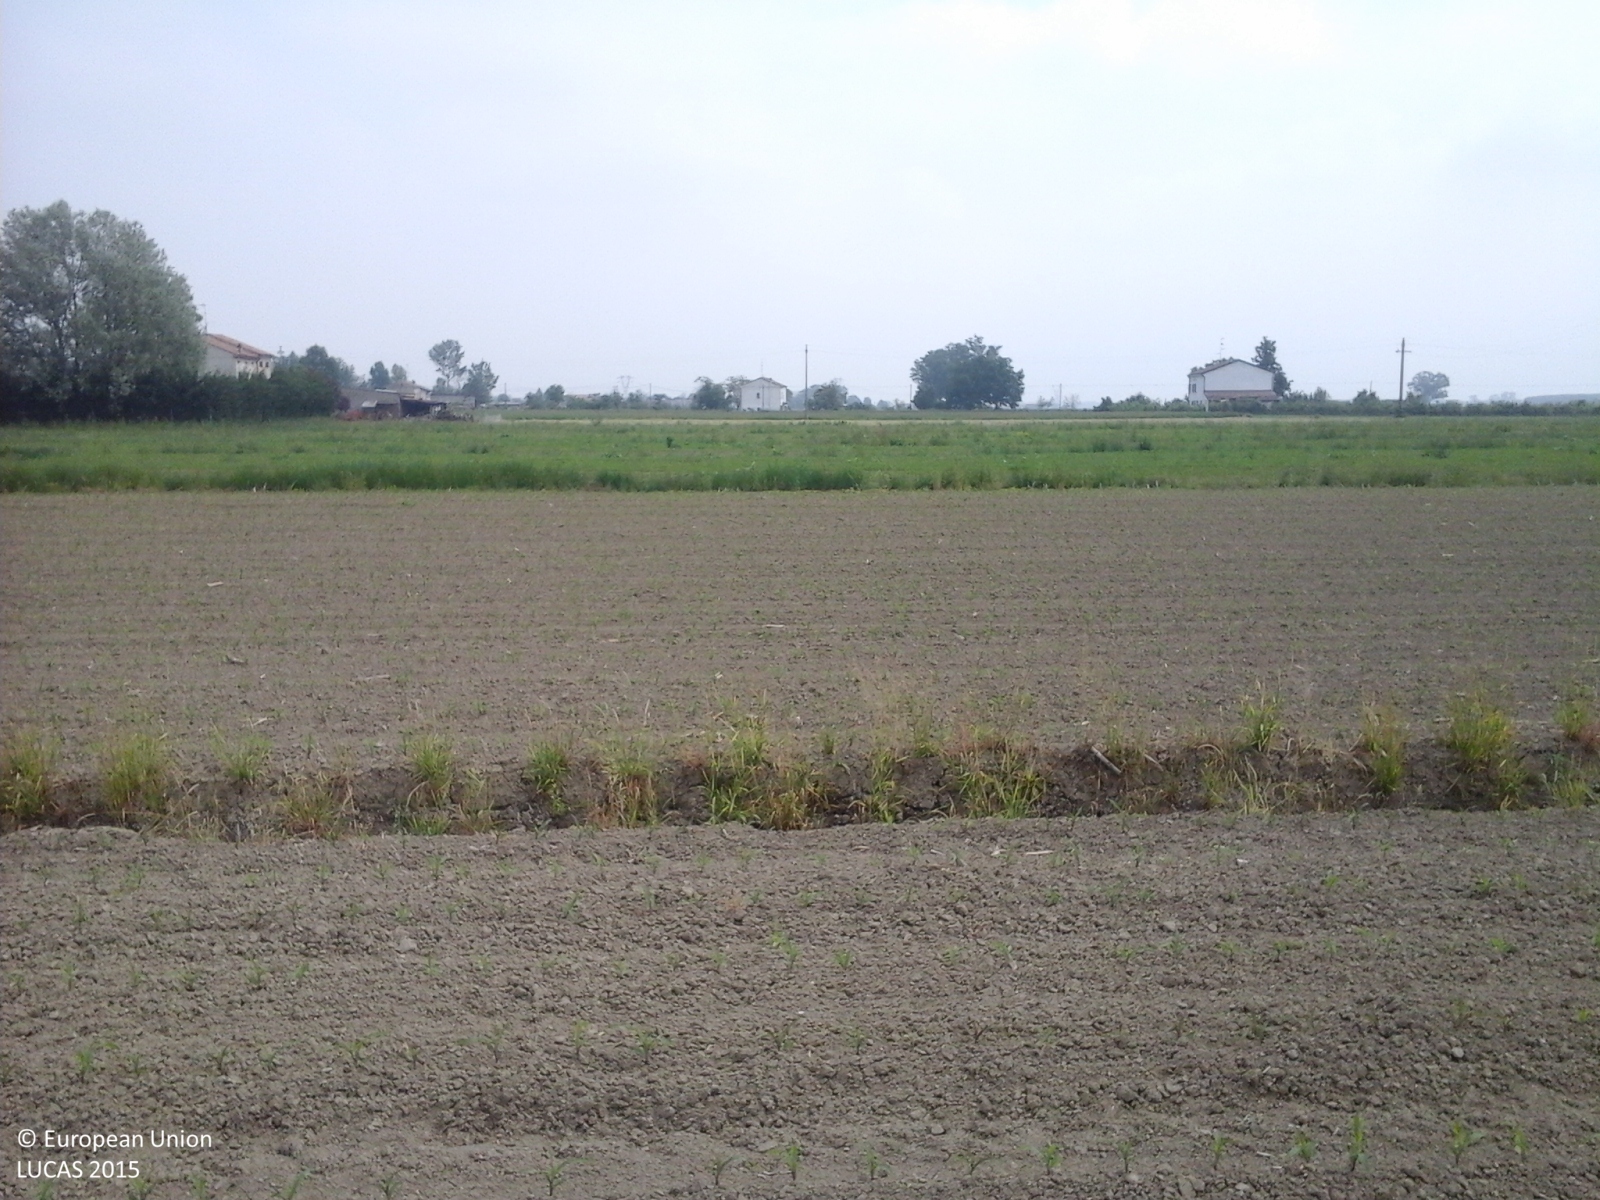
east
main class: Cropland
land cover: Maize
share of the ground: < 10 %
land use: Agriculture (excluding fallow land and kitchen gardens)
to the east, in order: Maize; Ditches and canals; Maize; Ditches and canals; Spontaneously vegetated surfaces; Ditches and canals; Spontaneously vegetated surfaces; Ditches and canals; Spontaneously vegetated surfaces; Ditches and canals; Lucerne; Ditches and canals; Lucerne; Ditches and canals; Lucerne; Ditches and canals; Lucerne; Ditches and canals; Lucerne; Electric lines; Lucerne; Ditches and canals; Lucerne
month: May
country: IT
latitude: 44.9071
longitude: 10.7205
